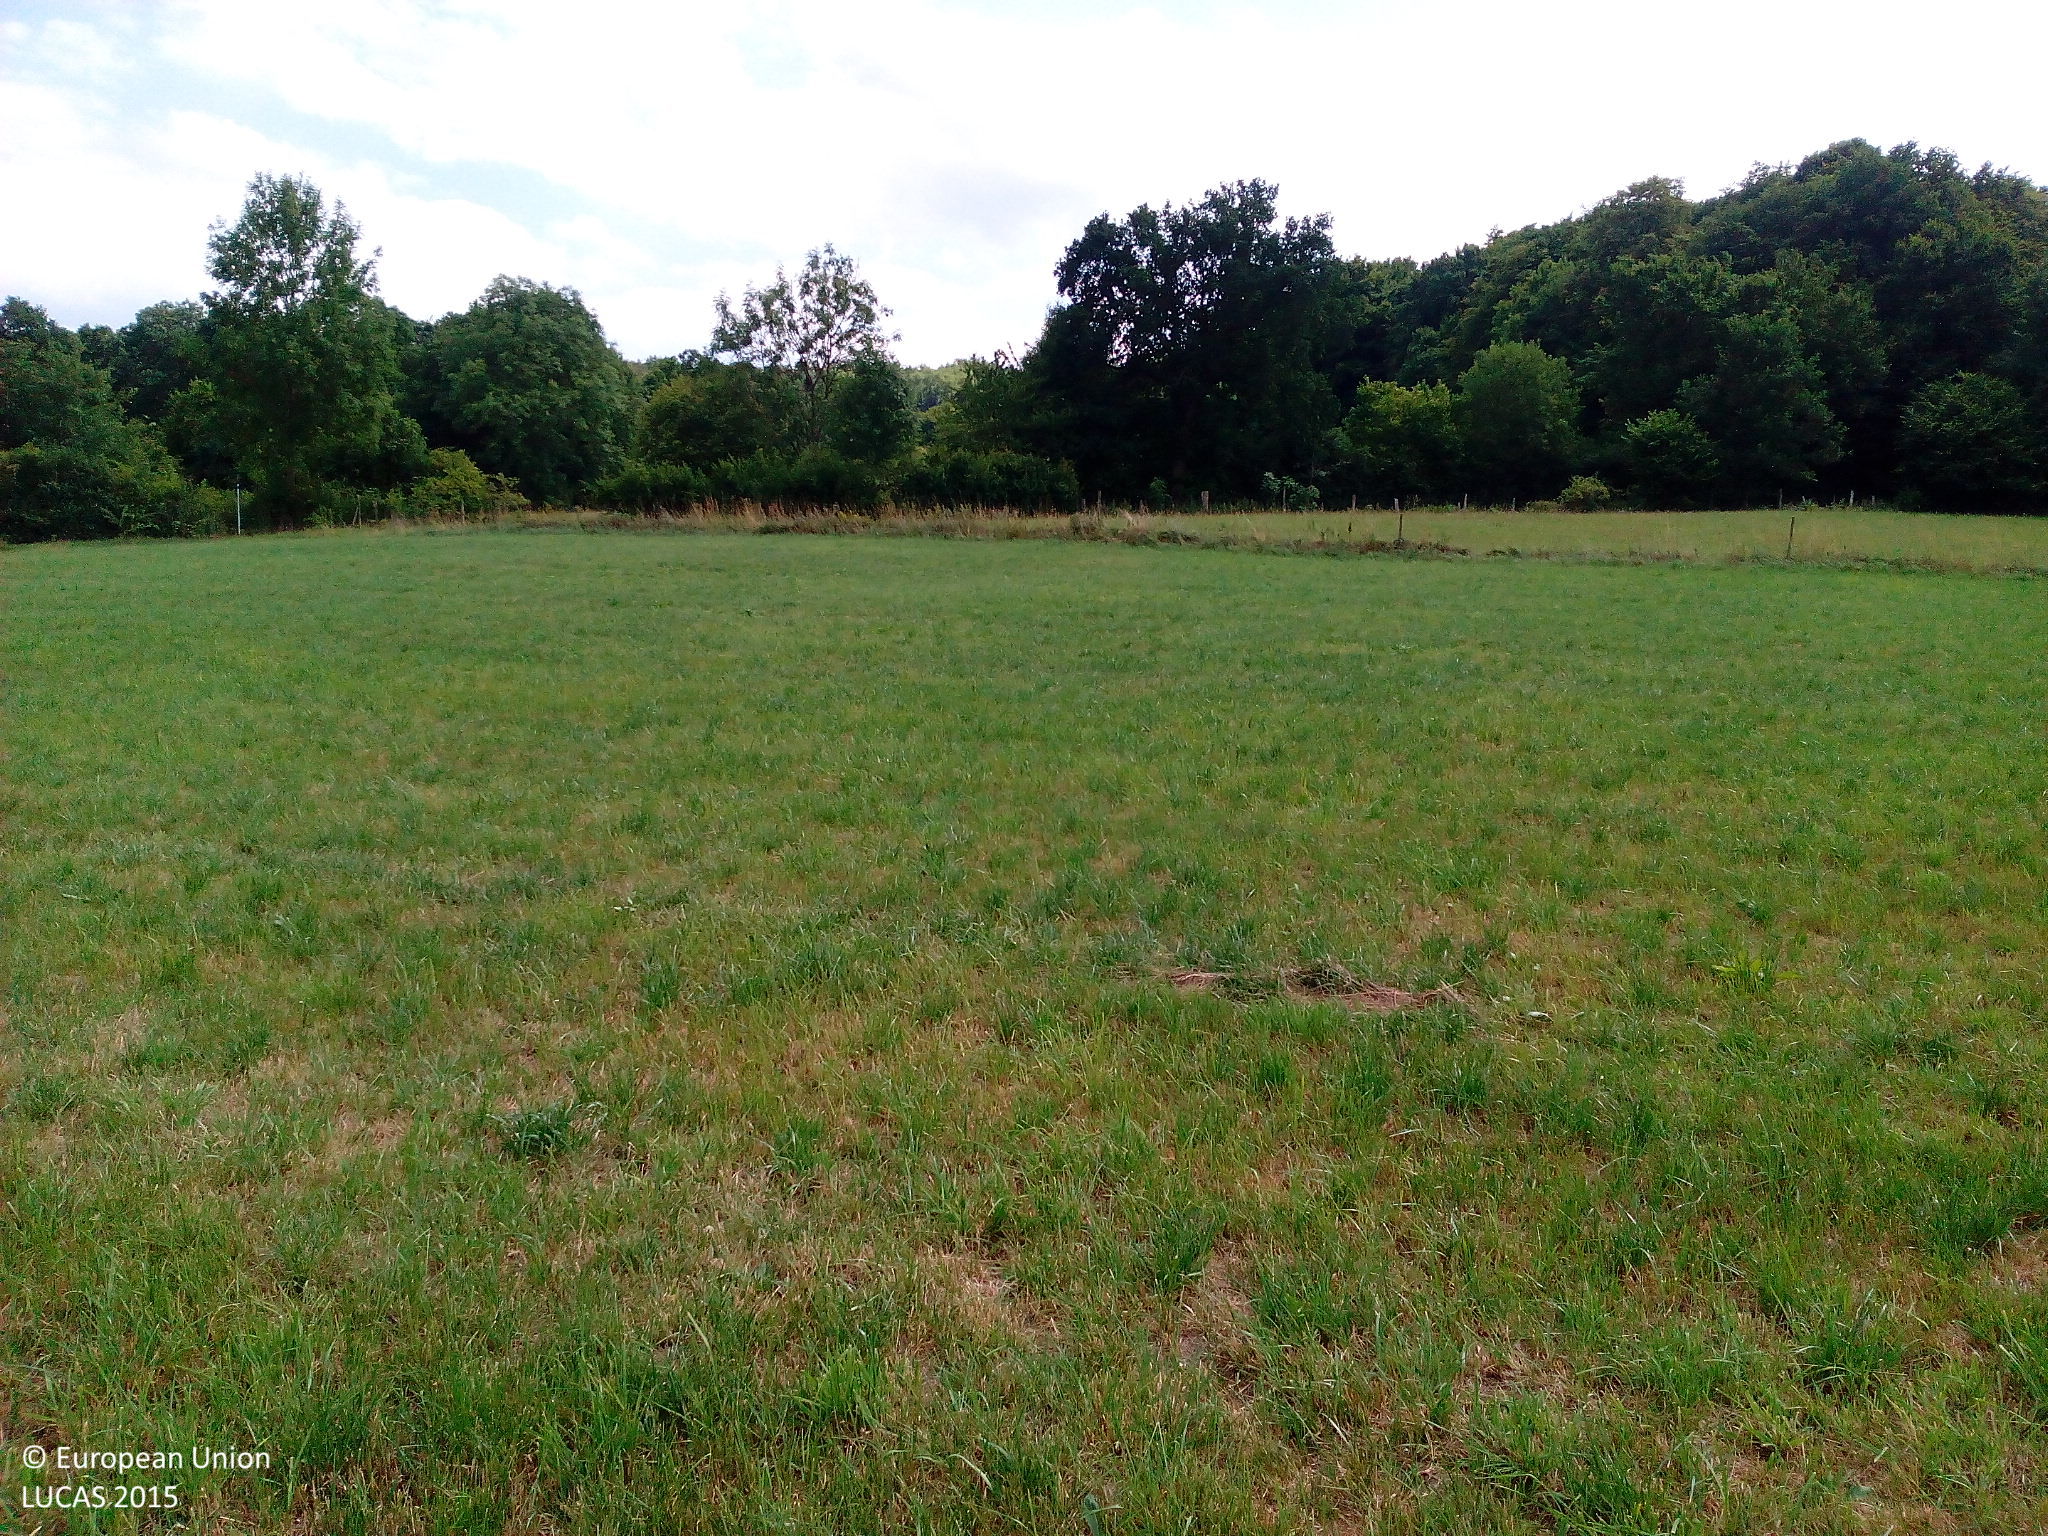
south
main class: Grassland
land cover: Grassland without tree/shrub cover
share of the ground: > 75 %
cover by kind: herbaceous plants 100 %
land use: Agriculture (excluding fallow land and kitchen gardens)
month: July
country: DE
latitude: 50.7056
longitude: 9.8726
